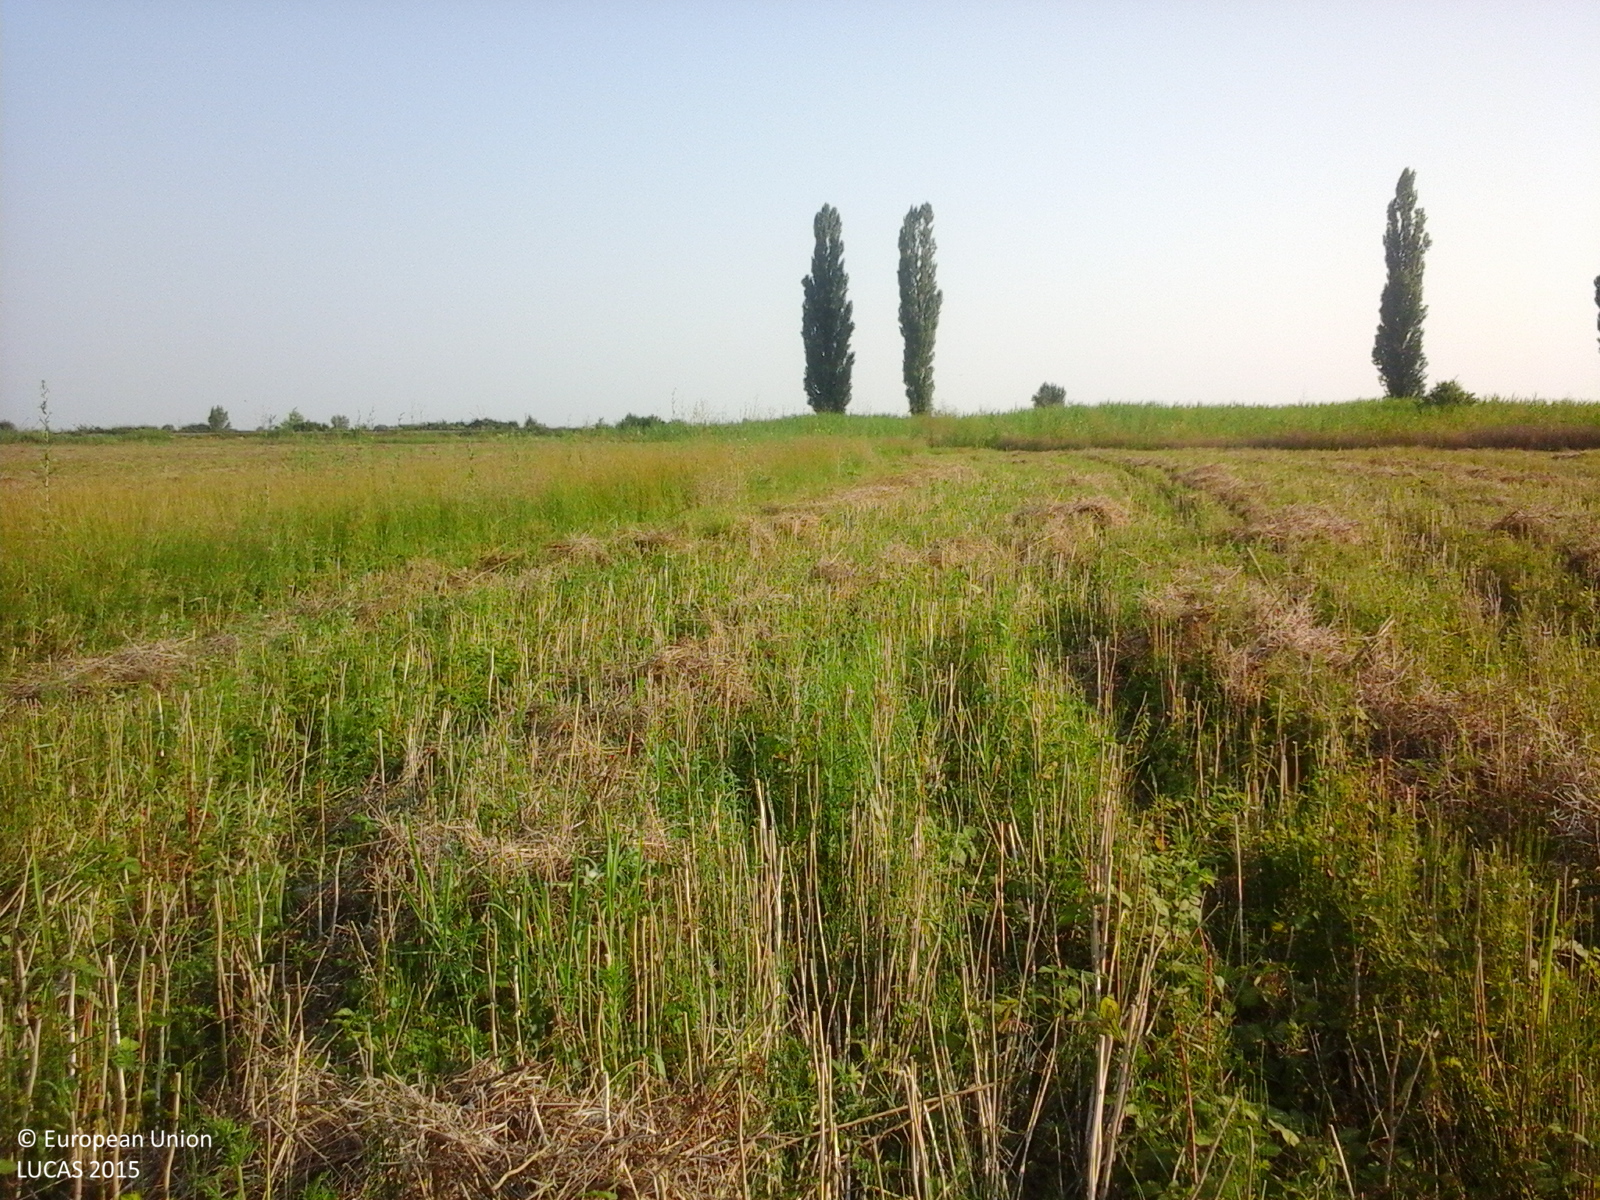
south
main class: Cropland
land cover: Rape and turnip rape
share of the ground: 50 - 75 %
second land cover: Spontaneously vegetated surfaces
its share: 25 - 50 %
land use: Agriculture (excluding fallow land and kitchen gardens)
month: July
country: RO
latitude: 44.6552
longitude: 25.6711
